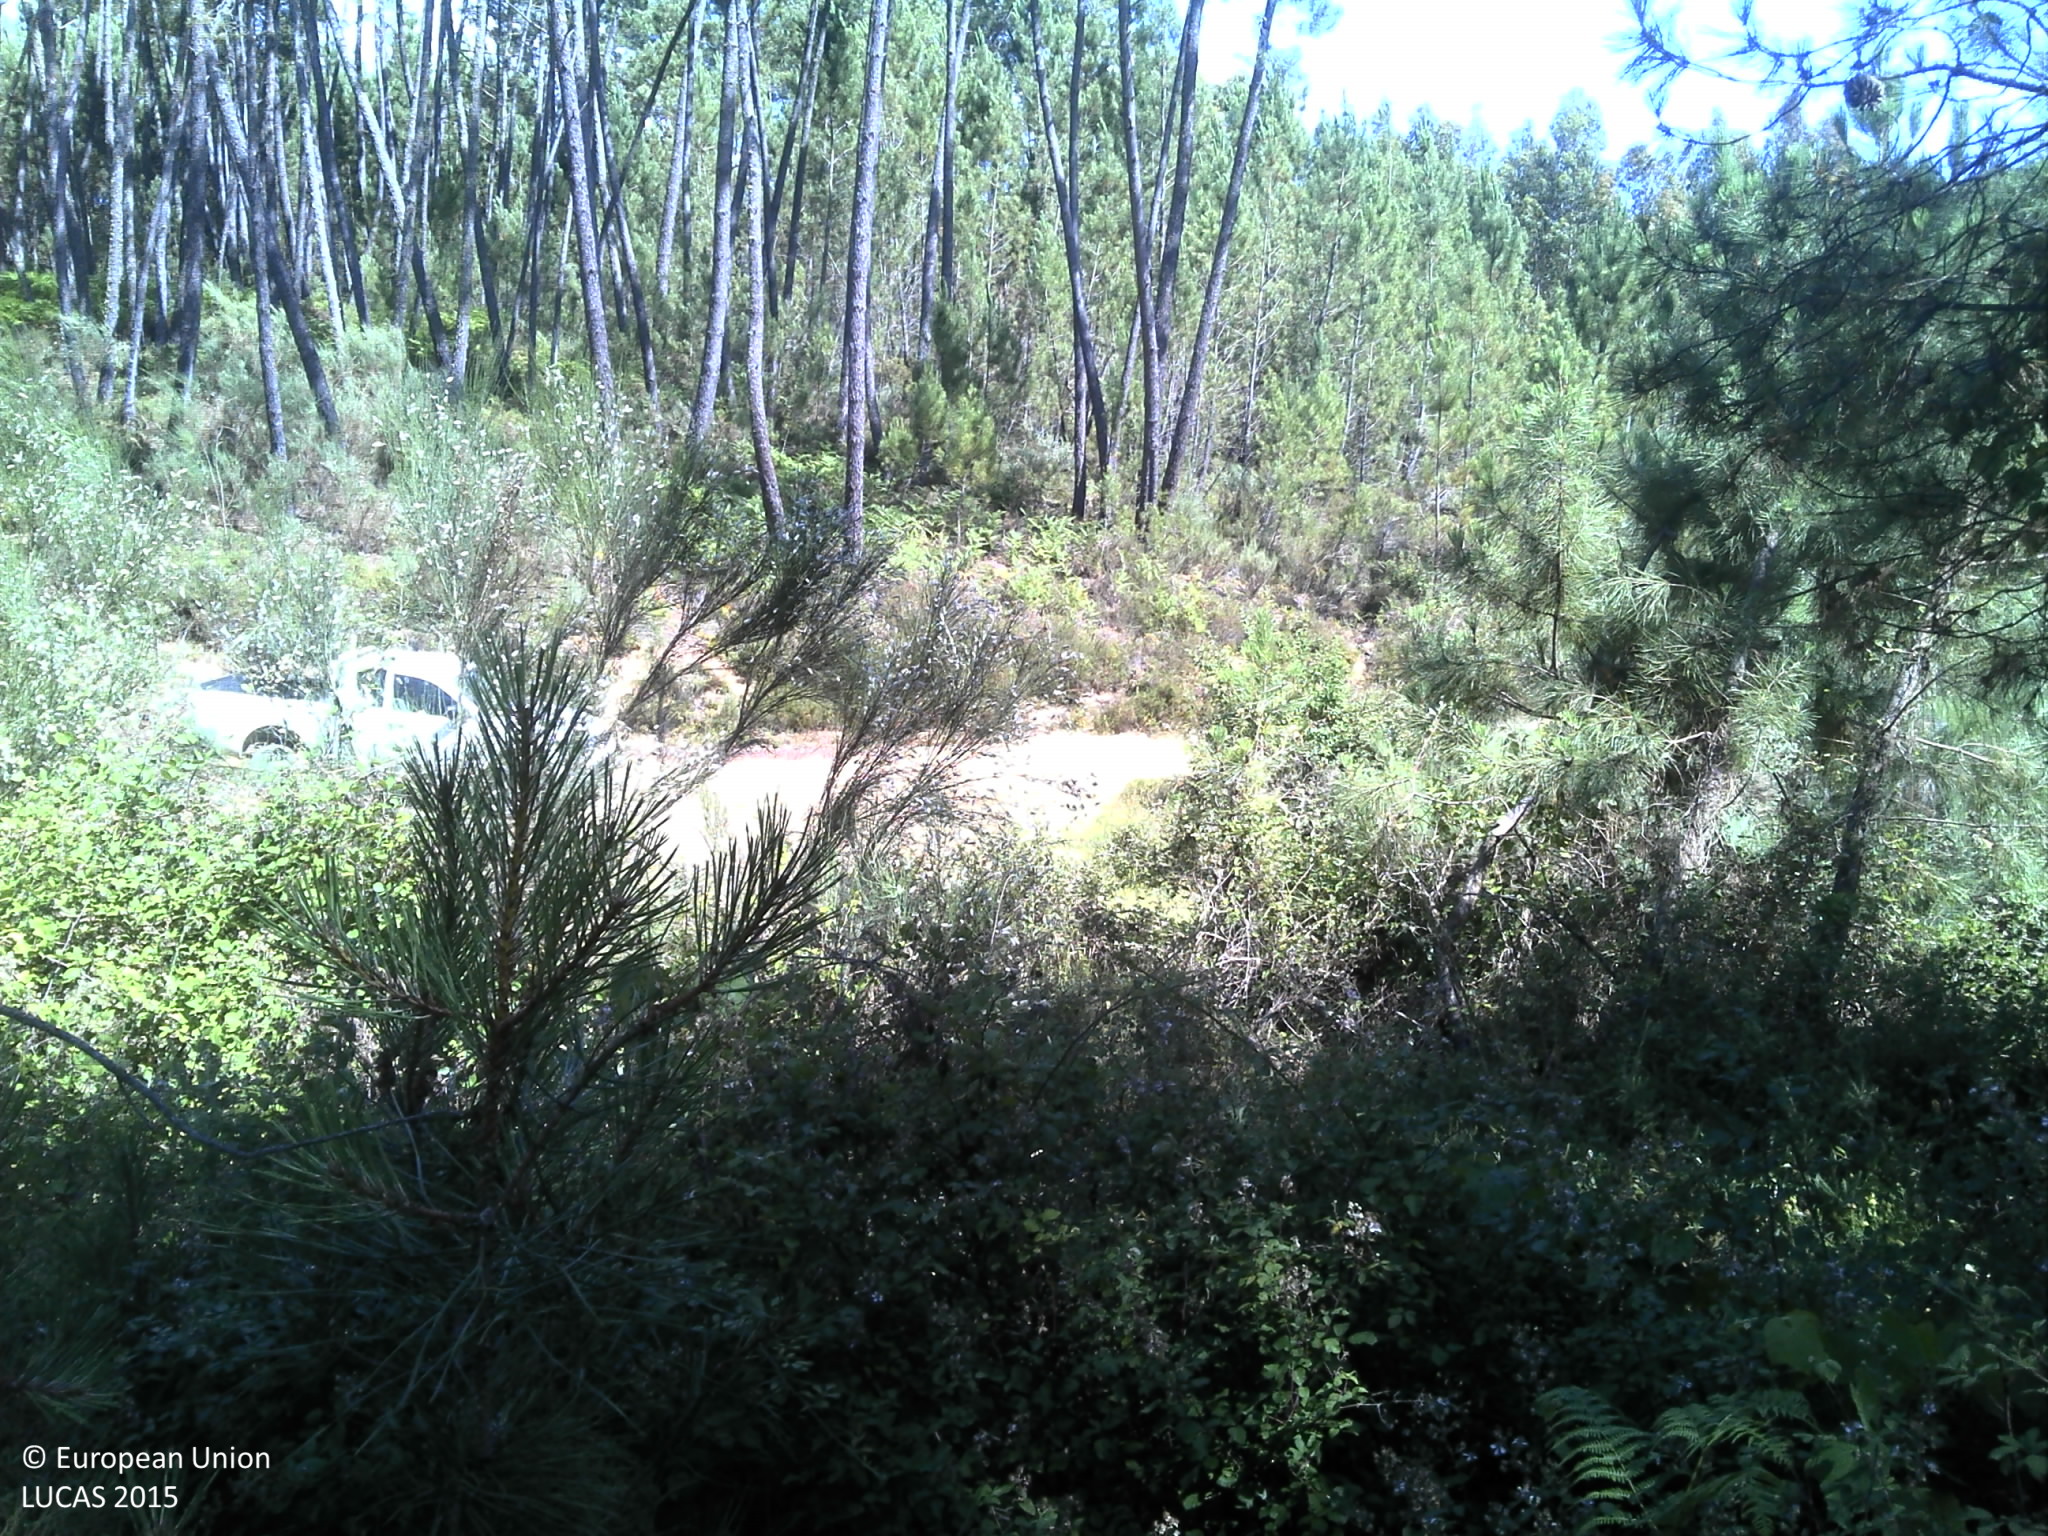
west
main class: Woodland
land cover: Pine dominated coniferous woodland
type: coniferous forest of the mediterranean region
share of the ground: 25 - 50 %
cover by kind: coniferous forest trees 50 %, shrubs 35 %, unconsolidated bare surface 15 %
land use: Forestry
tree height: > 5 m
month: July
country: PT
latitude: 39.9645
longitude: -7.8469
